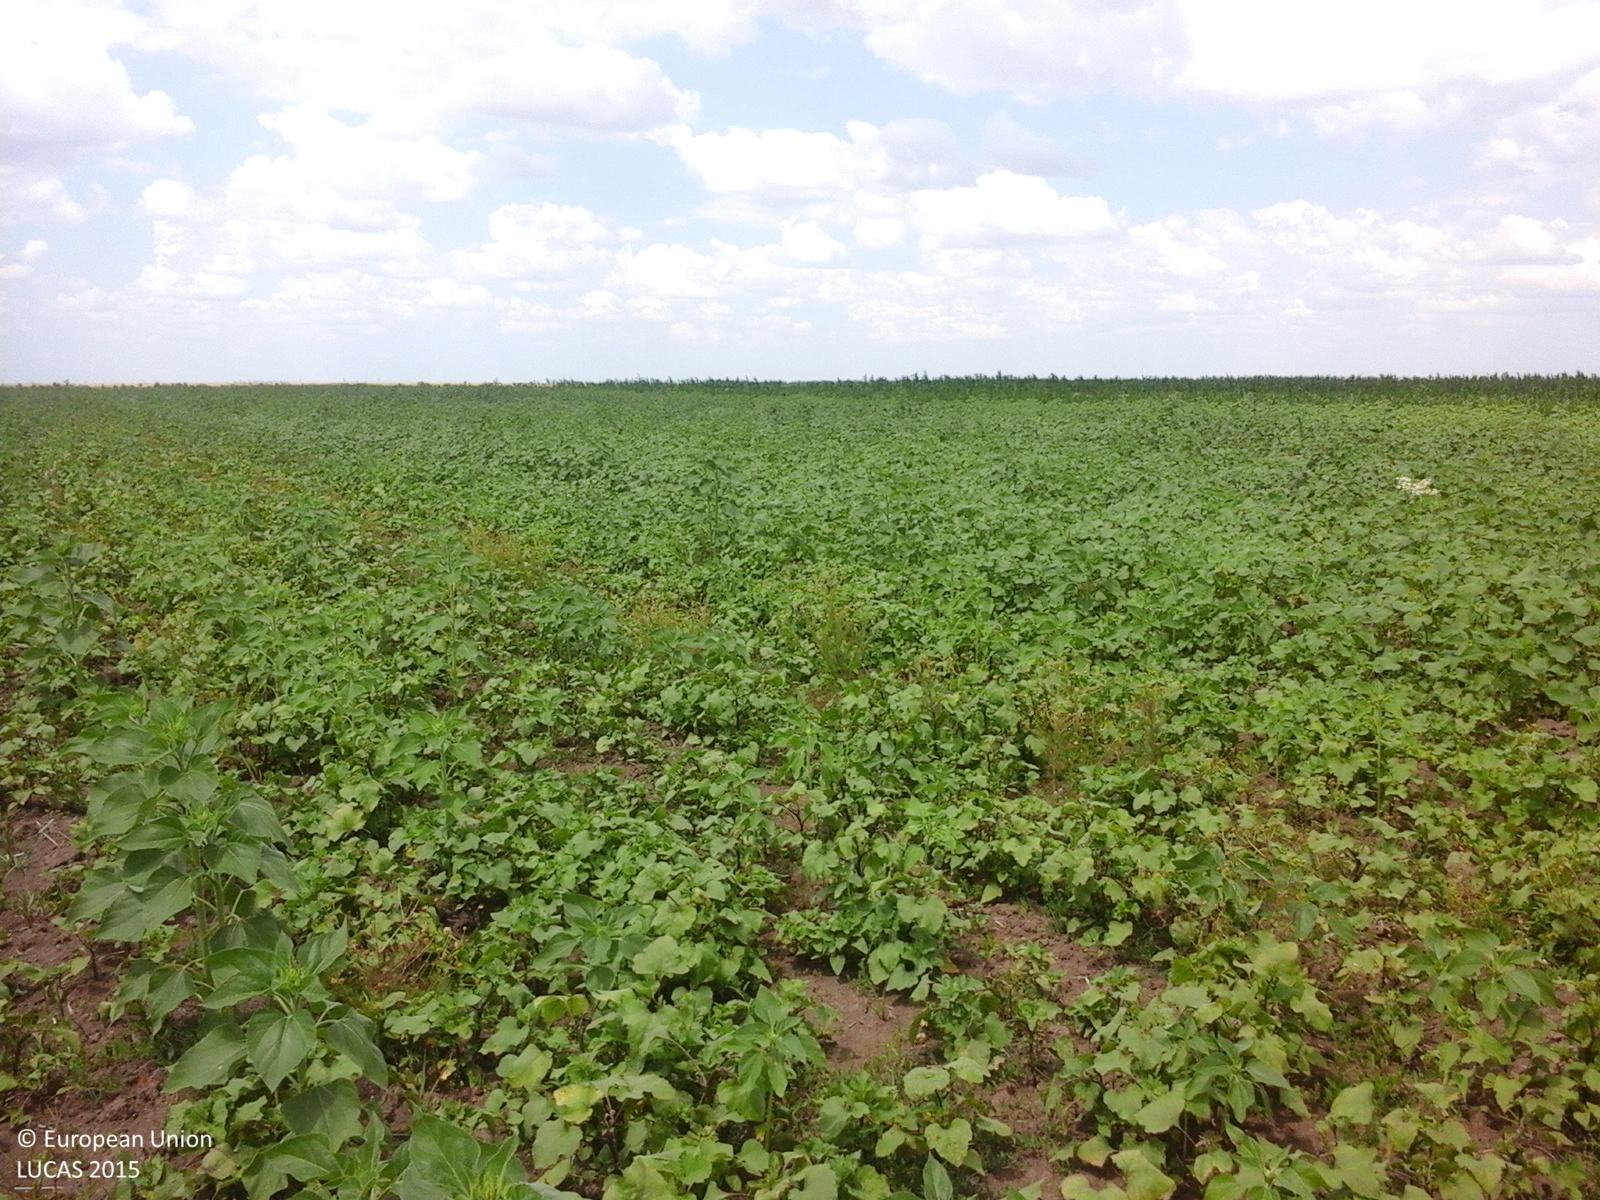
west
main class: Cropland
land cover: Sunflower
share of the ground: > 75 %
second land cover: Spontaneously vegetated surfaces
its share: > 75 %
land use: Agriculture (excluding fallow land and kitchen gardens)
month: July
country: RO
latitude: 44.2738
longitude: 25.2821
